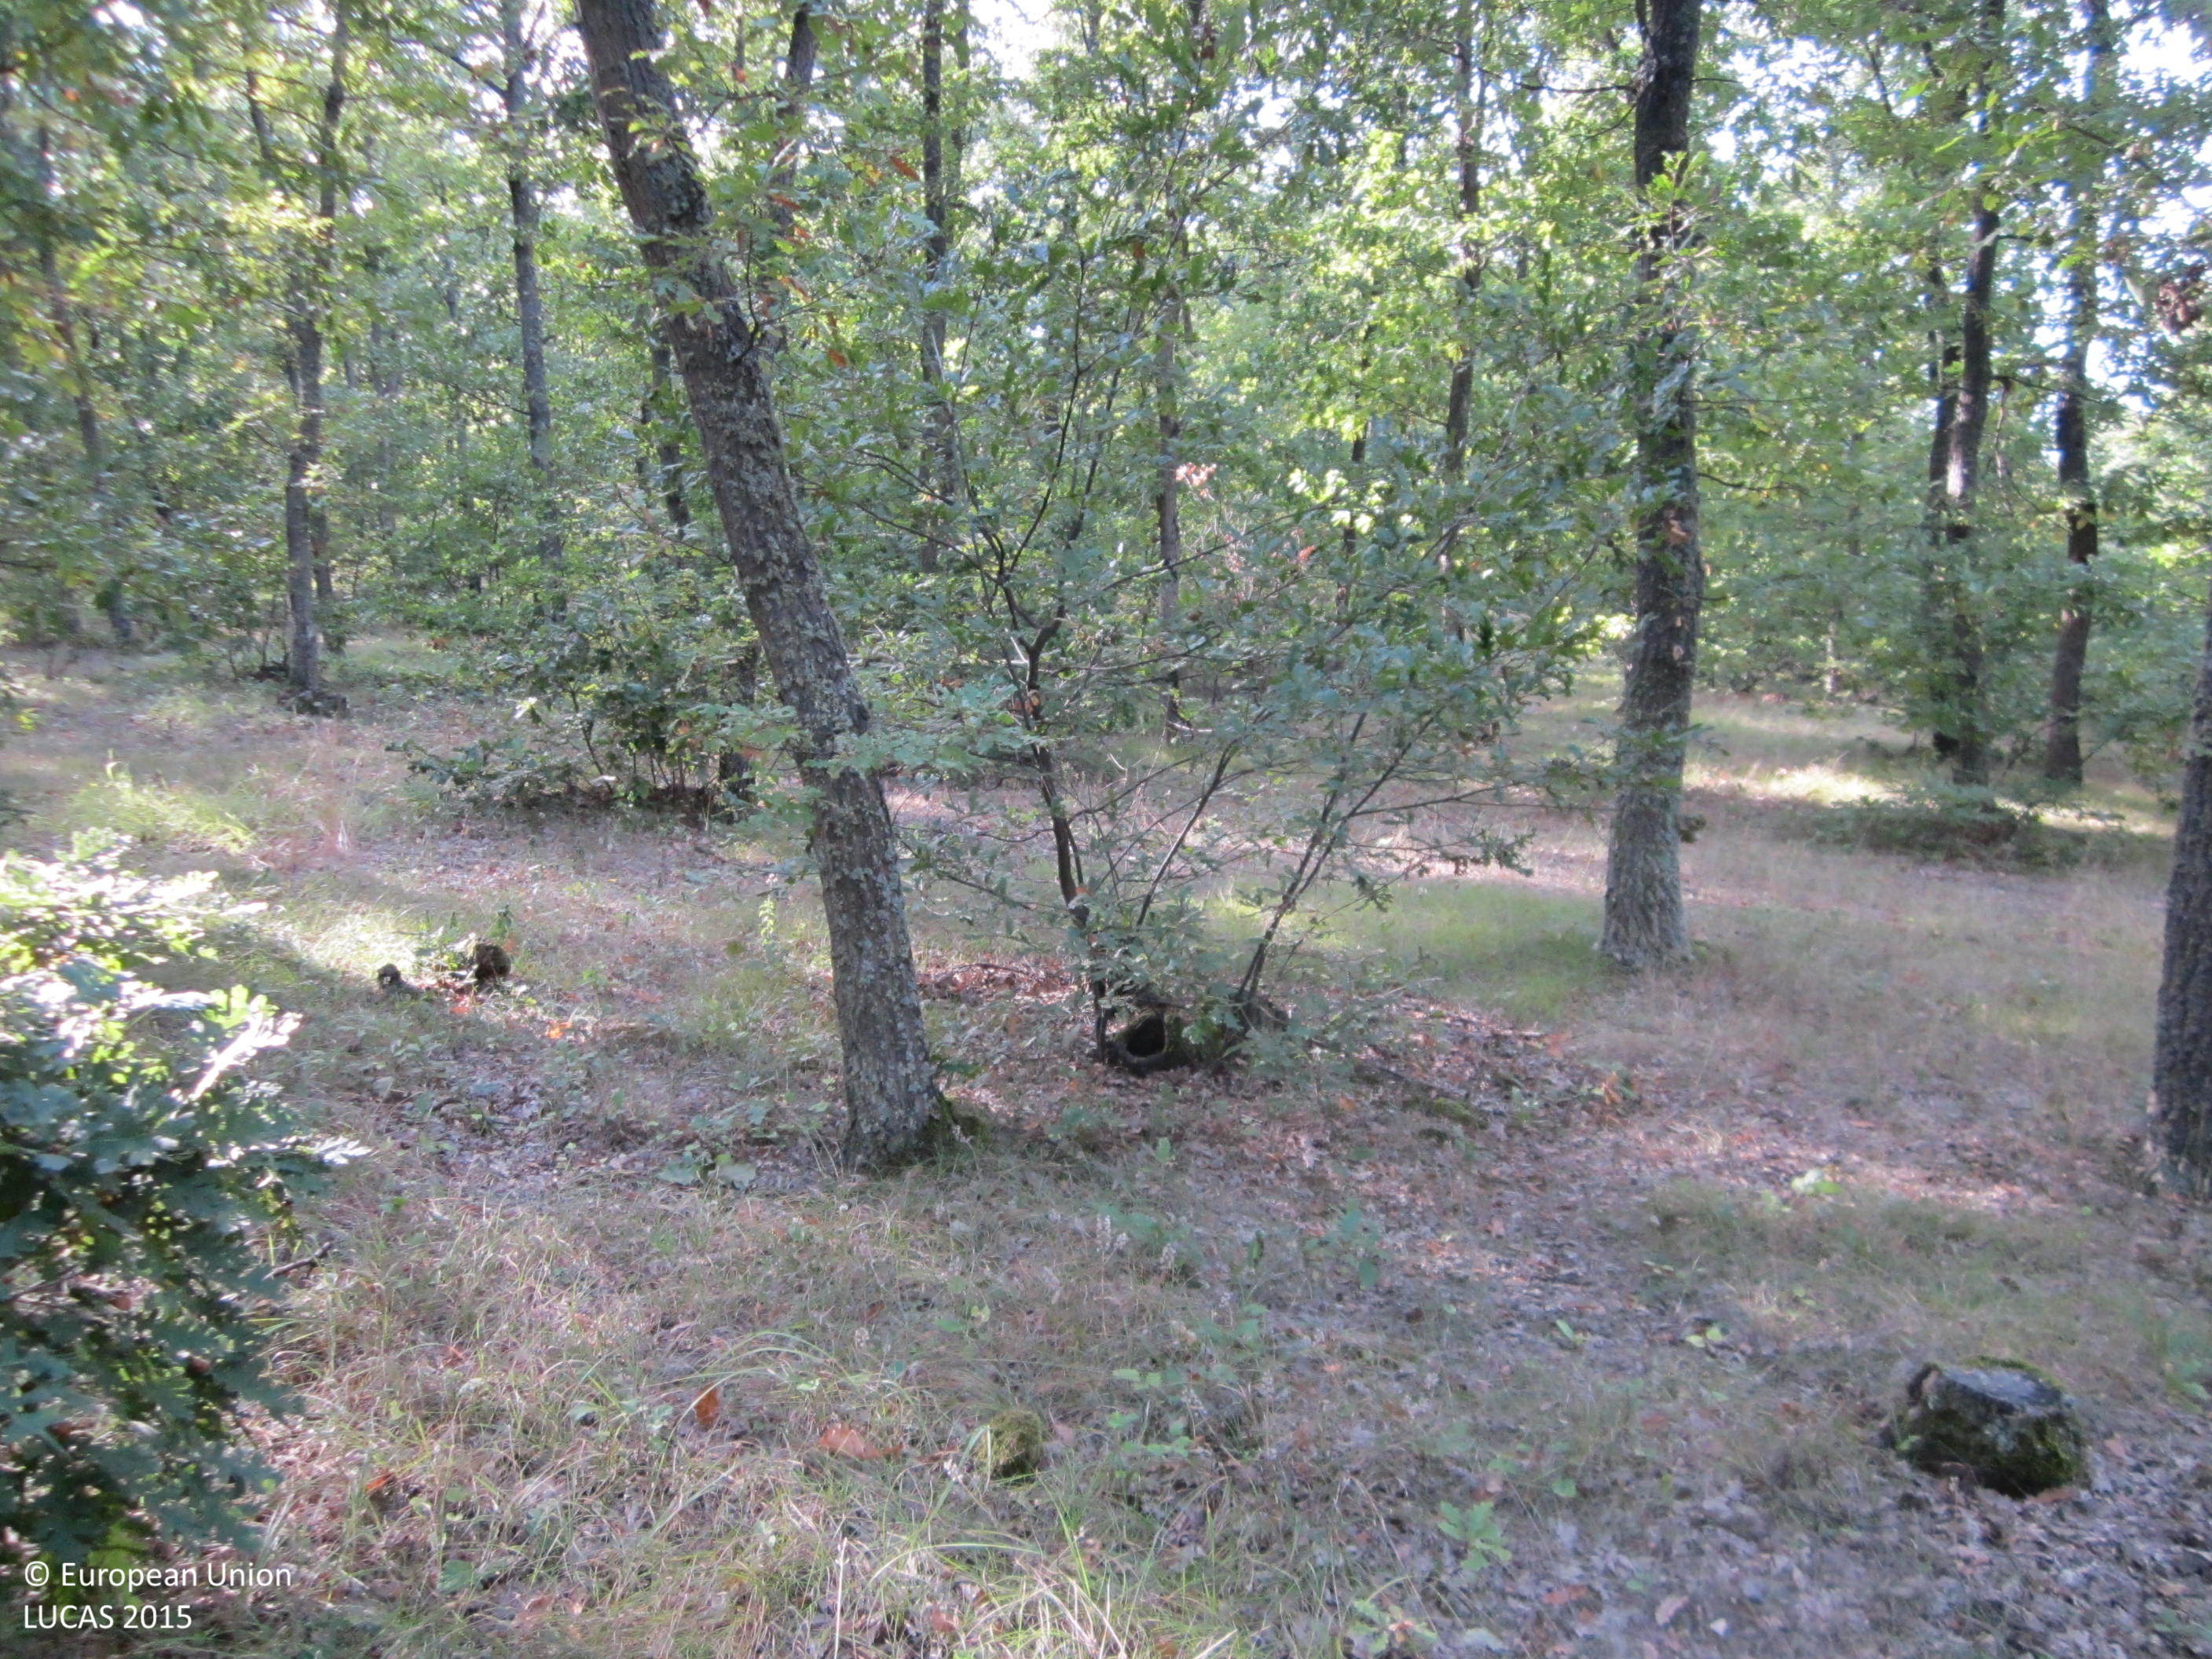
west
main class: Woodland
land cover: Broadleaved woodland
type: acidophilous oak and oak-birch forest
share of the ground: 50 - 75 %
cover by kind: broadleaved forest trees 65 %, herbaceous plants 35 %
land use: Forestry
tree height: > 5 m
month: October
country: BG
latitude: 42.8097
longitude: 26.8715
